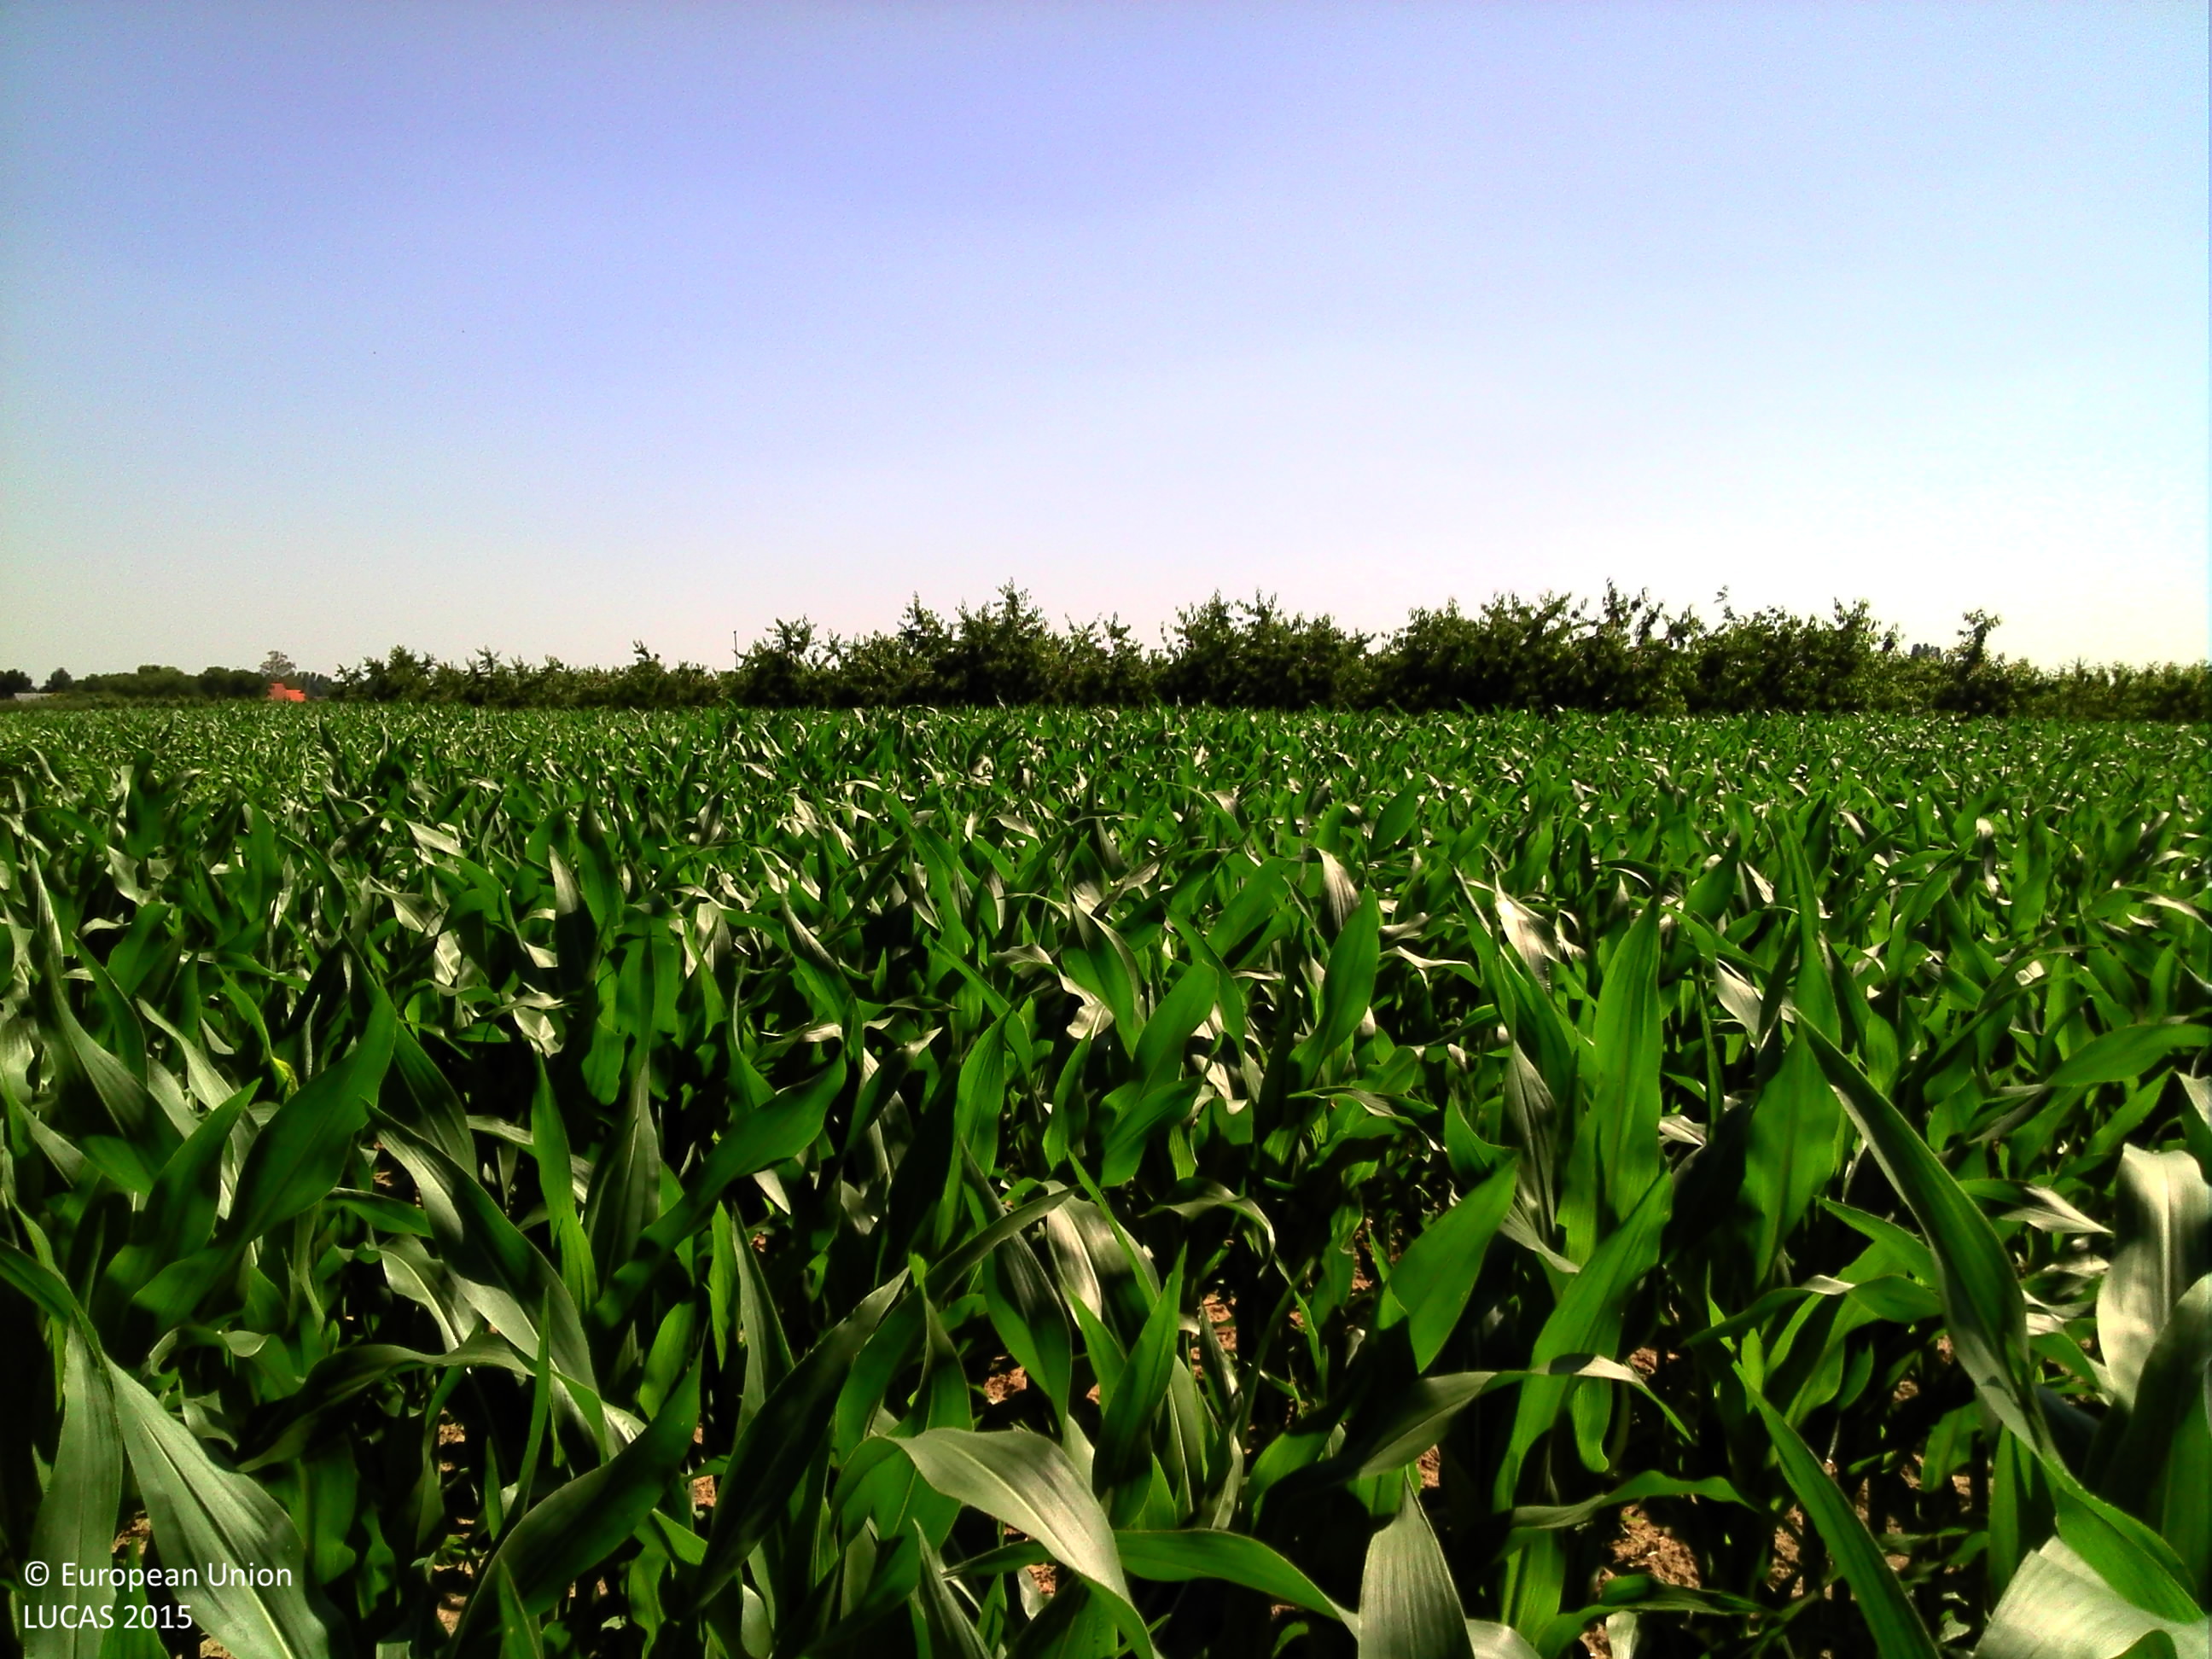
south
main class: Cropland
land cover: Maize
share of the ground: > 75 %
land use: Agriculture (excluding fallow land and kitchen gardens)
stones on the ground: < 10 %
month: June
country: BE
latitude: 50.8426
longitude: 5.2686
